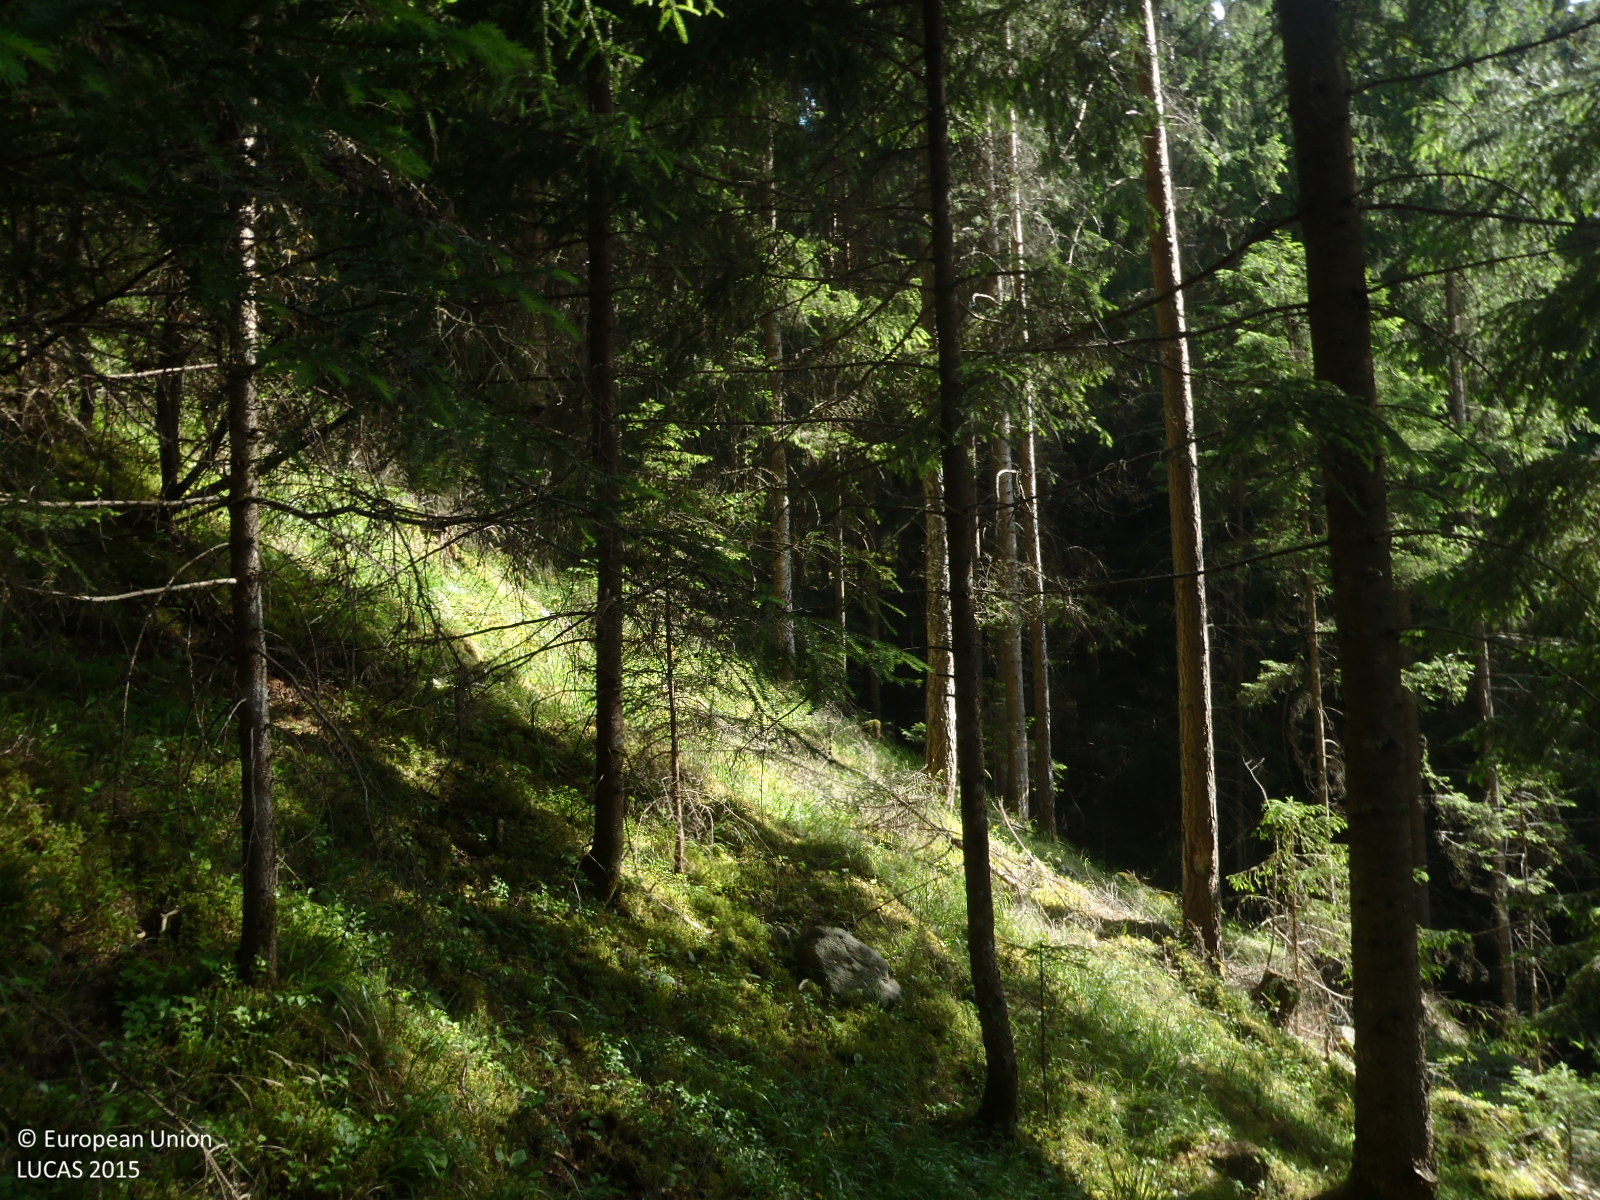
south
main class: Woodland
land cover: Pine dominated coniferous woodland
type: alpine coniferous forest
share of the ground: > 75 %
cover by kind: coniferous forest trees 85 %, herbaceous plants 10 %, lichens and mosses 5 %
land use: Forestry
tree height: > 5 m
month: June
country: AT
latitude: 47.2124
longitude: 10.8310
